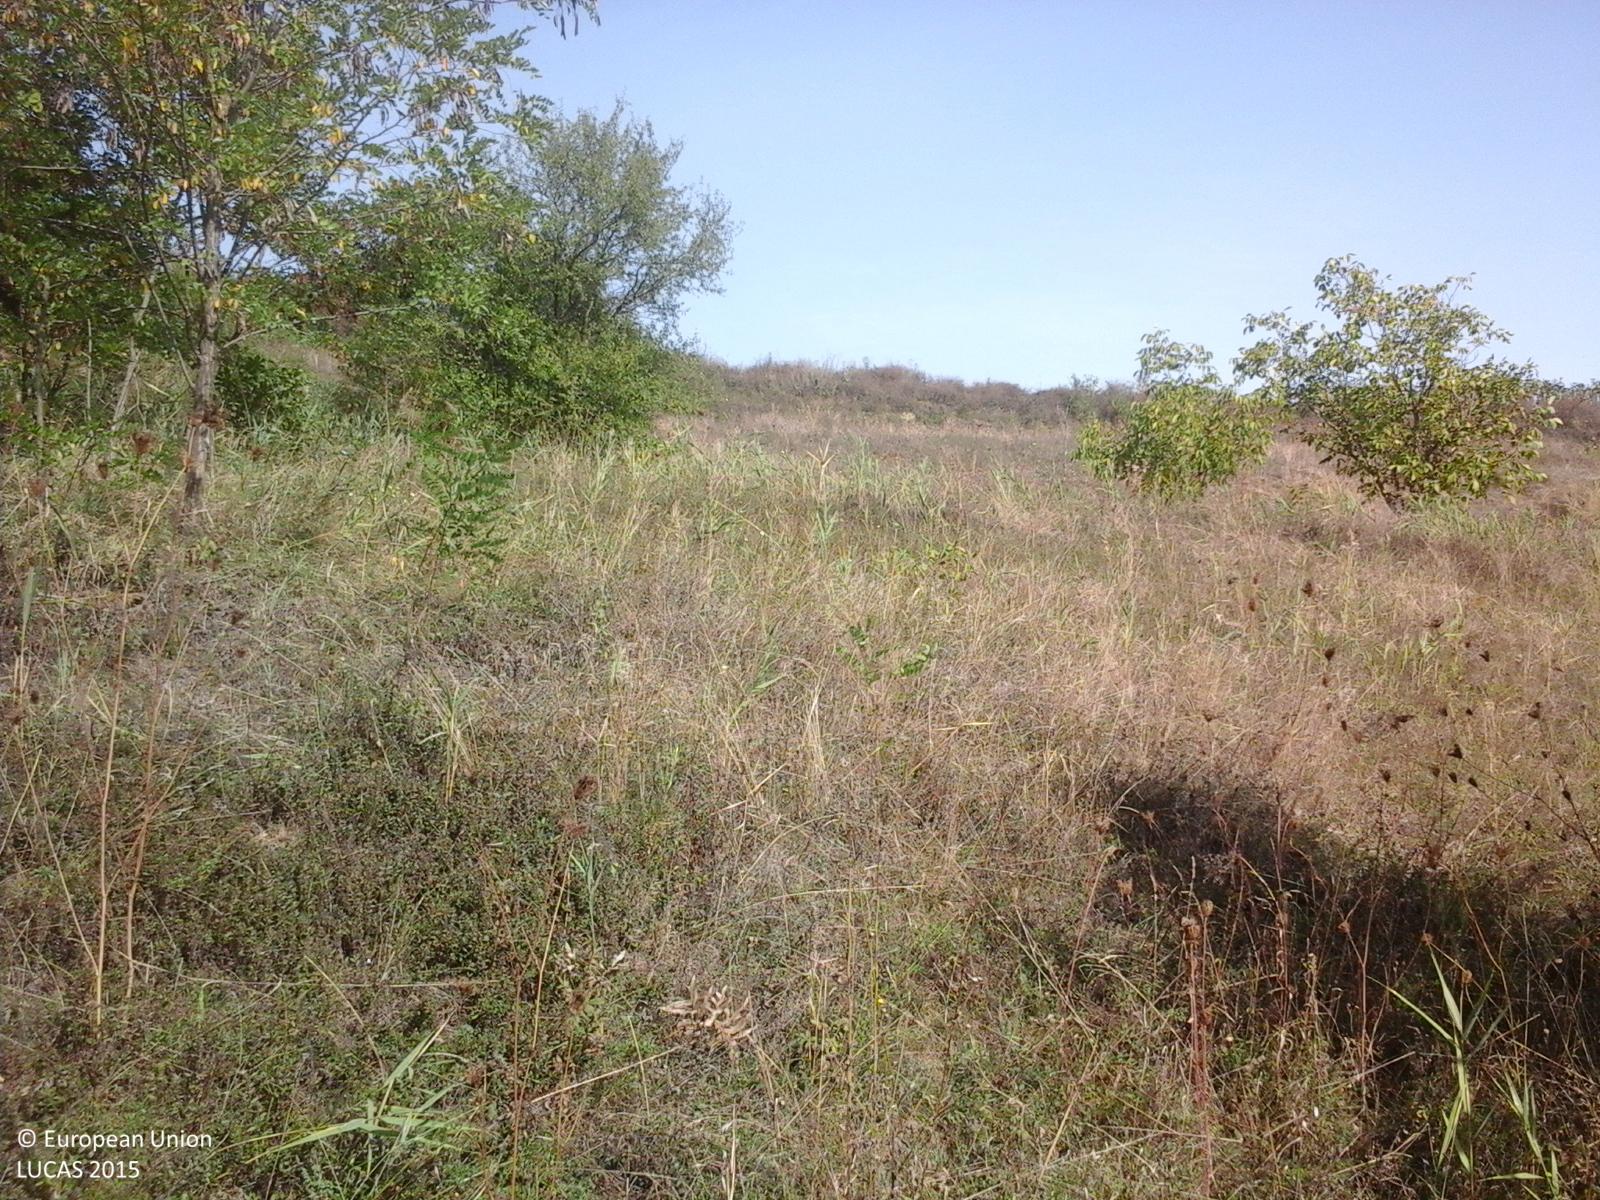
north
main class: Grassland
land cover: Grassland with sparse tree/shrub cover
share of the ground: > 75 %
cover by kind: herbaceous plants 95 %, broadleaved forest trees 5 %
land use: Fallow land
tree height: < 5 m
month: September
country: RO
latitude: 46.6789
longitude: 24.1876
